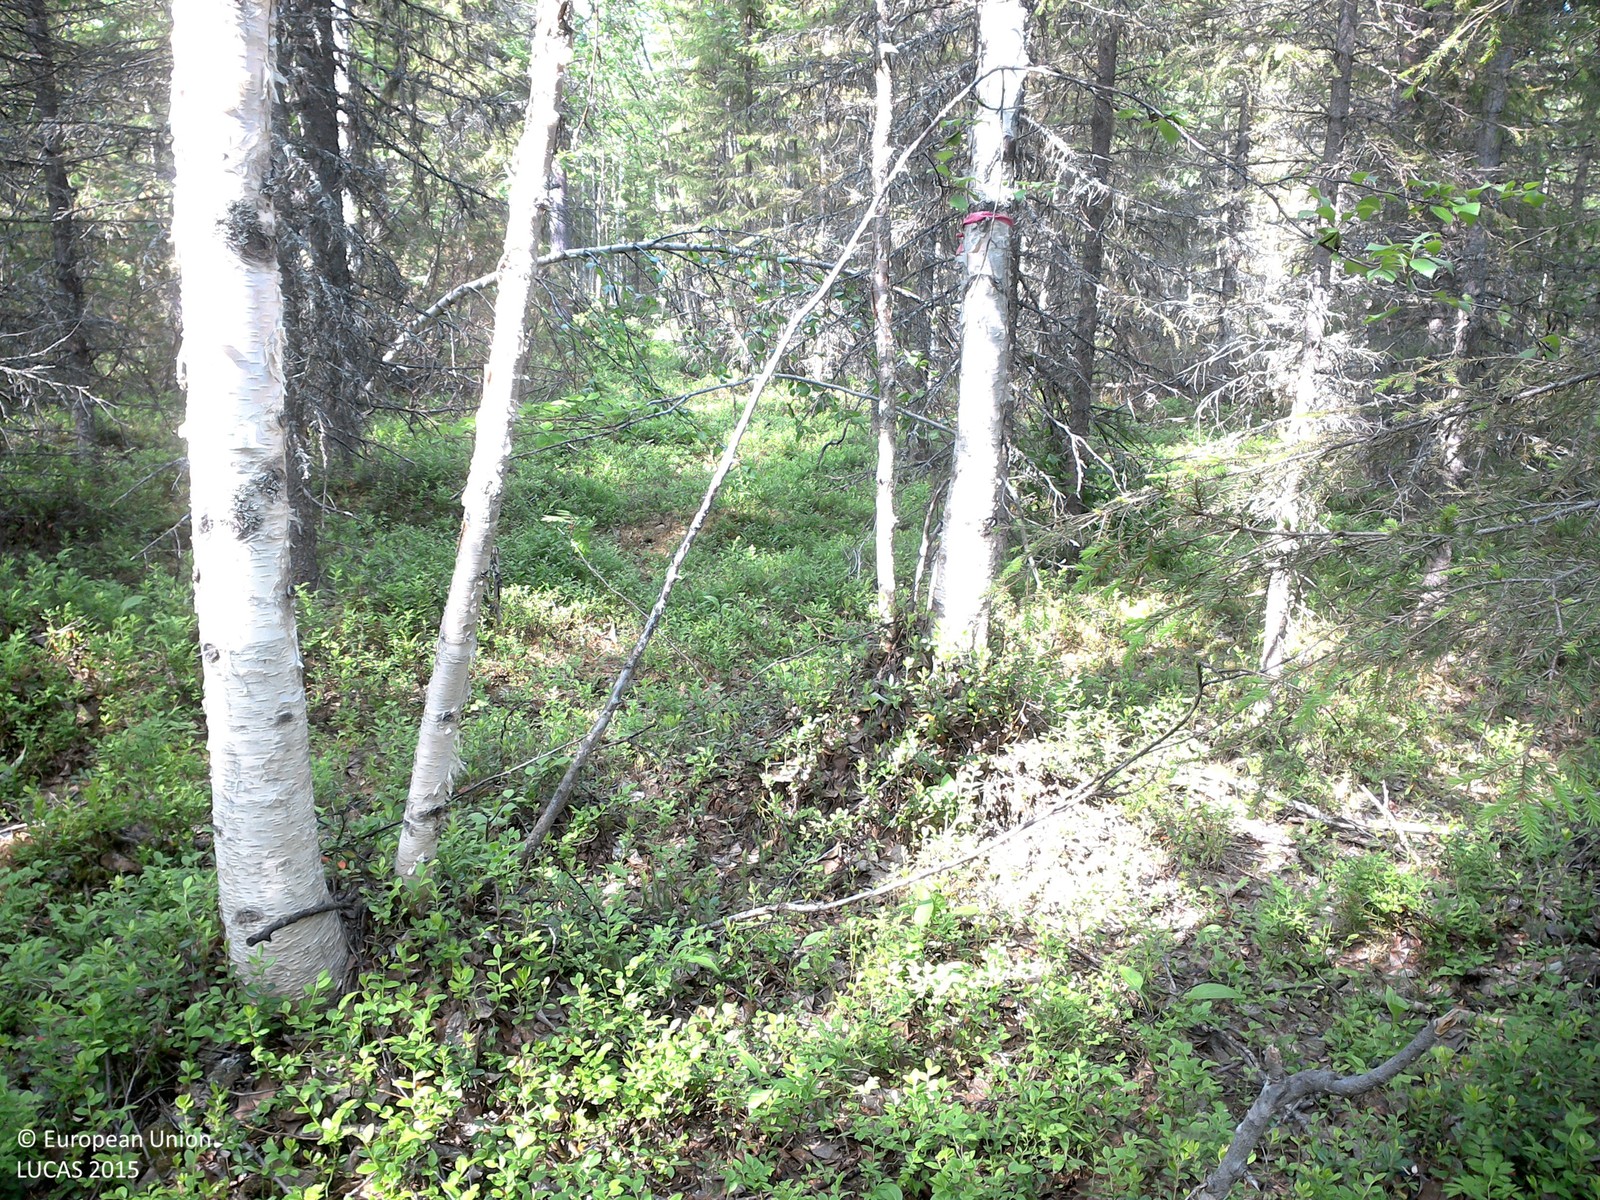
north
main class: Woodland
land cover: Spruce dominated mixed woodland
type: boreal forest
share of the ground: 10 - 25 %
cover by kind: shrubs 55 %, coniferous forest trees 30 %, broadleaved forest trees 15 %
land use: Forestry
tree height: > 5 m
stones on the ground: < 10 %
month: July
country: SE
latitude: 66.8483
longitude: 23.5874
